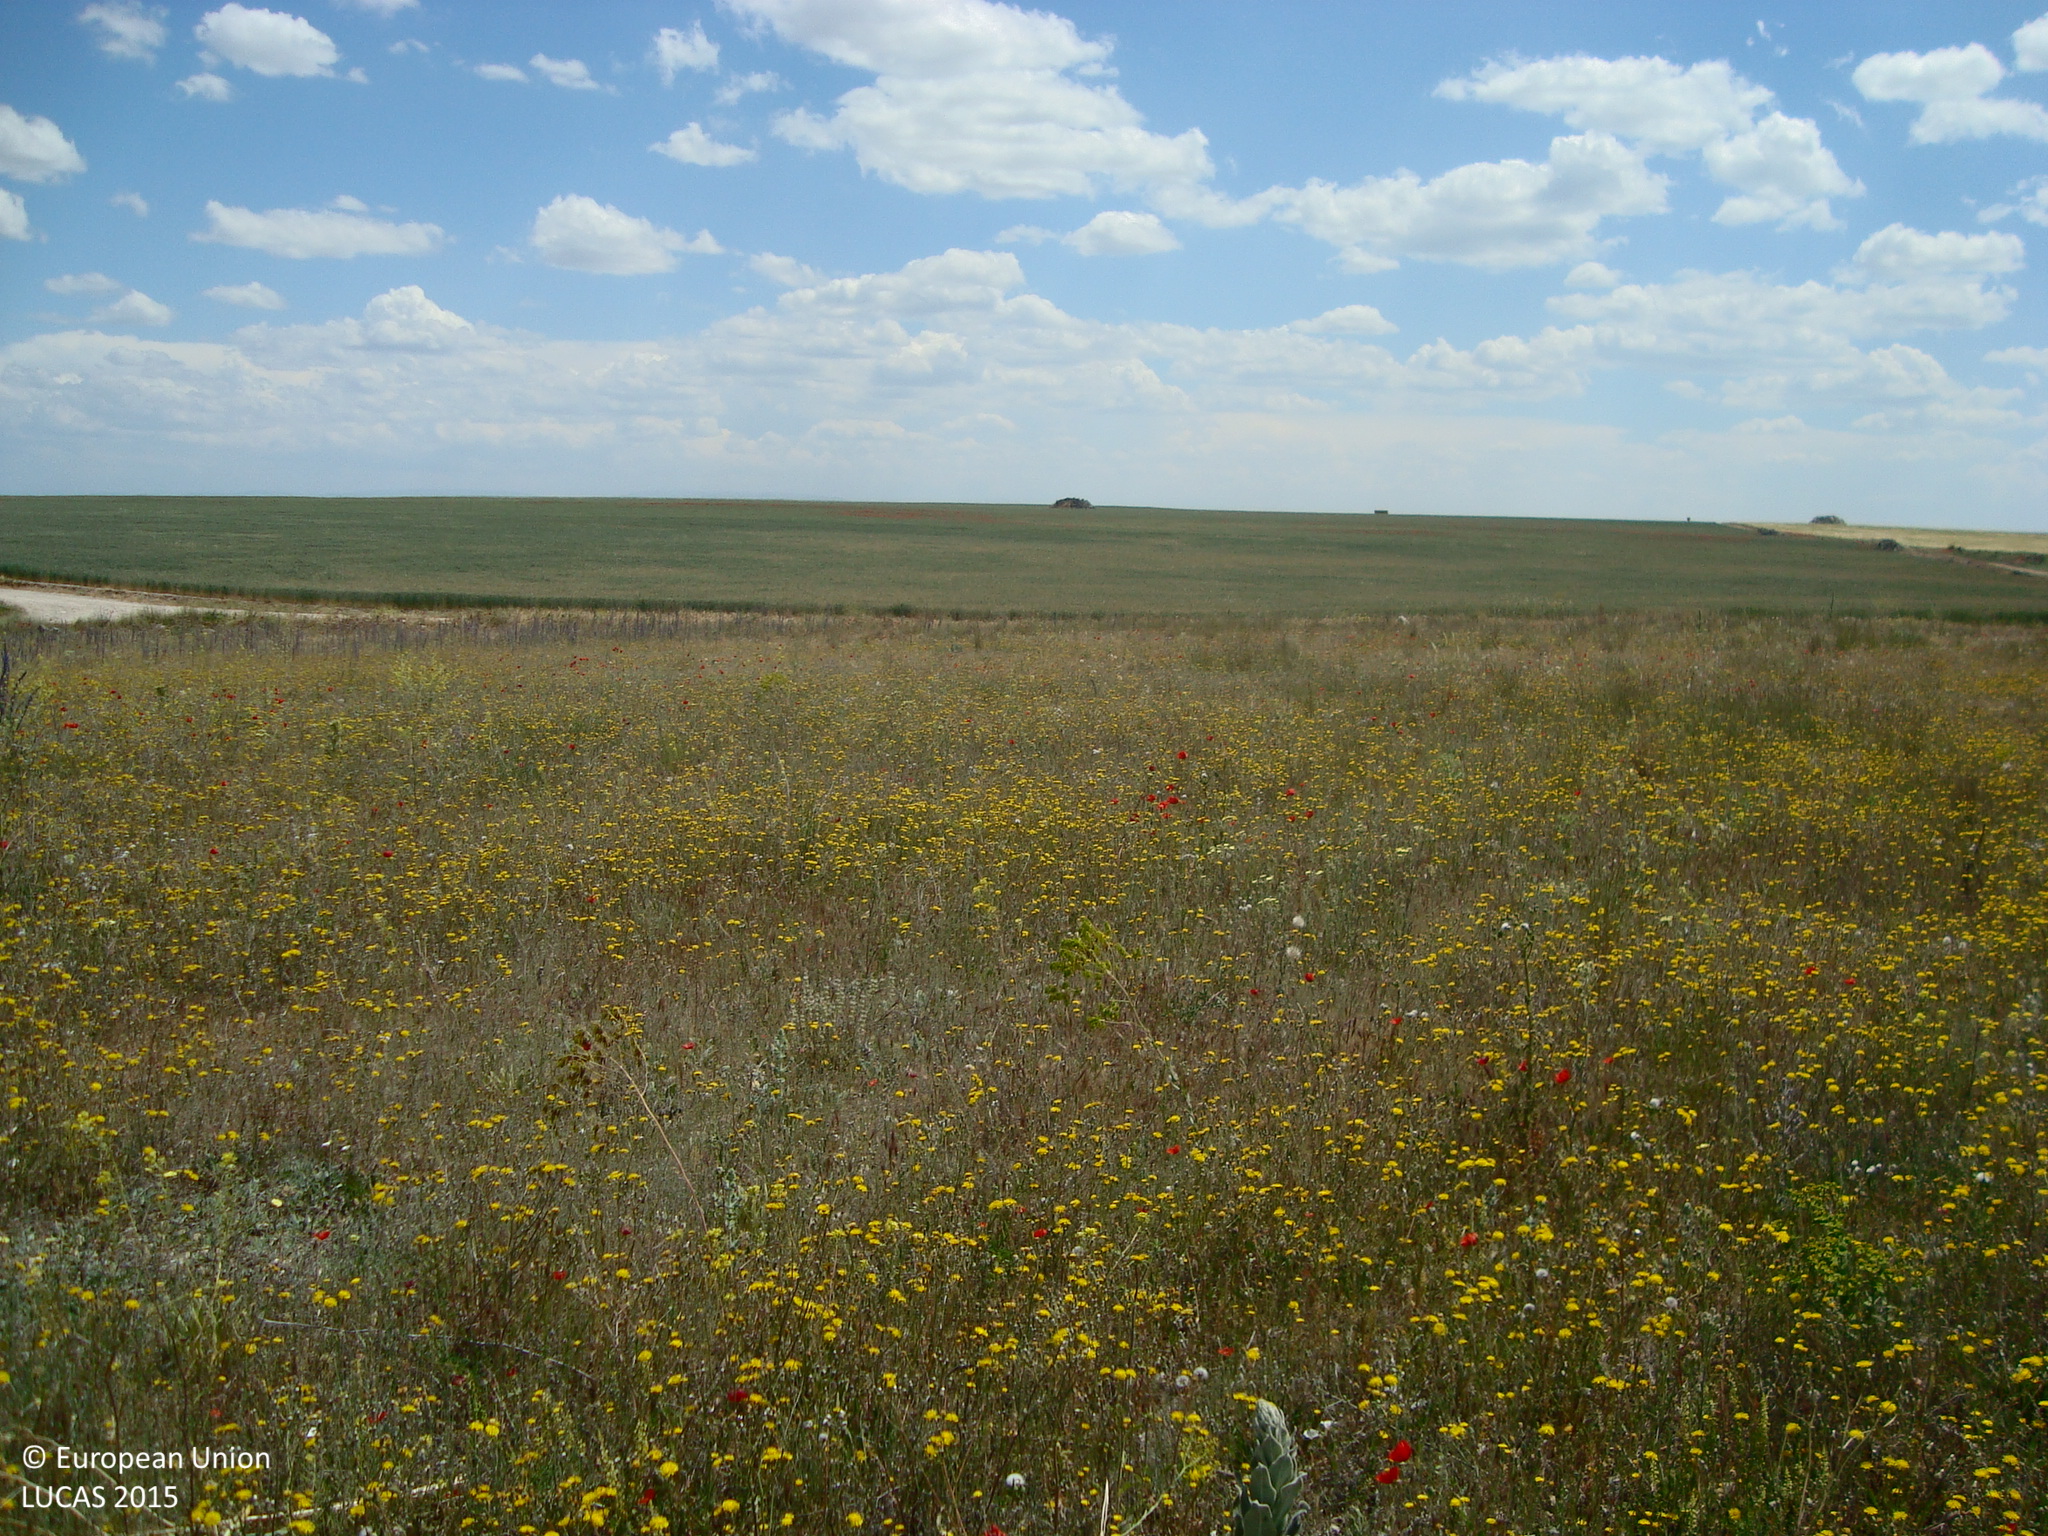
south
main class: Grassland
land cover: Grassland without tree/shrub cover
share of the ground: > 75 %
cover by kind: herbaceous plants 95 %, unconsolidated bare surface 5 %
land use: Abandoned areas
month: May
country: ES
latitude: 41.5594
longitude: -4.0497
